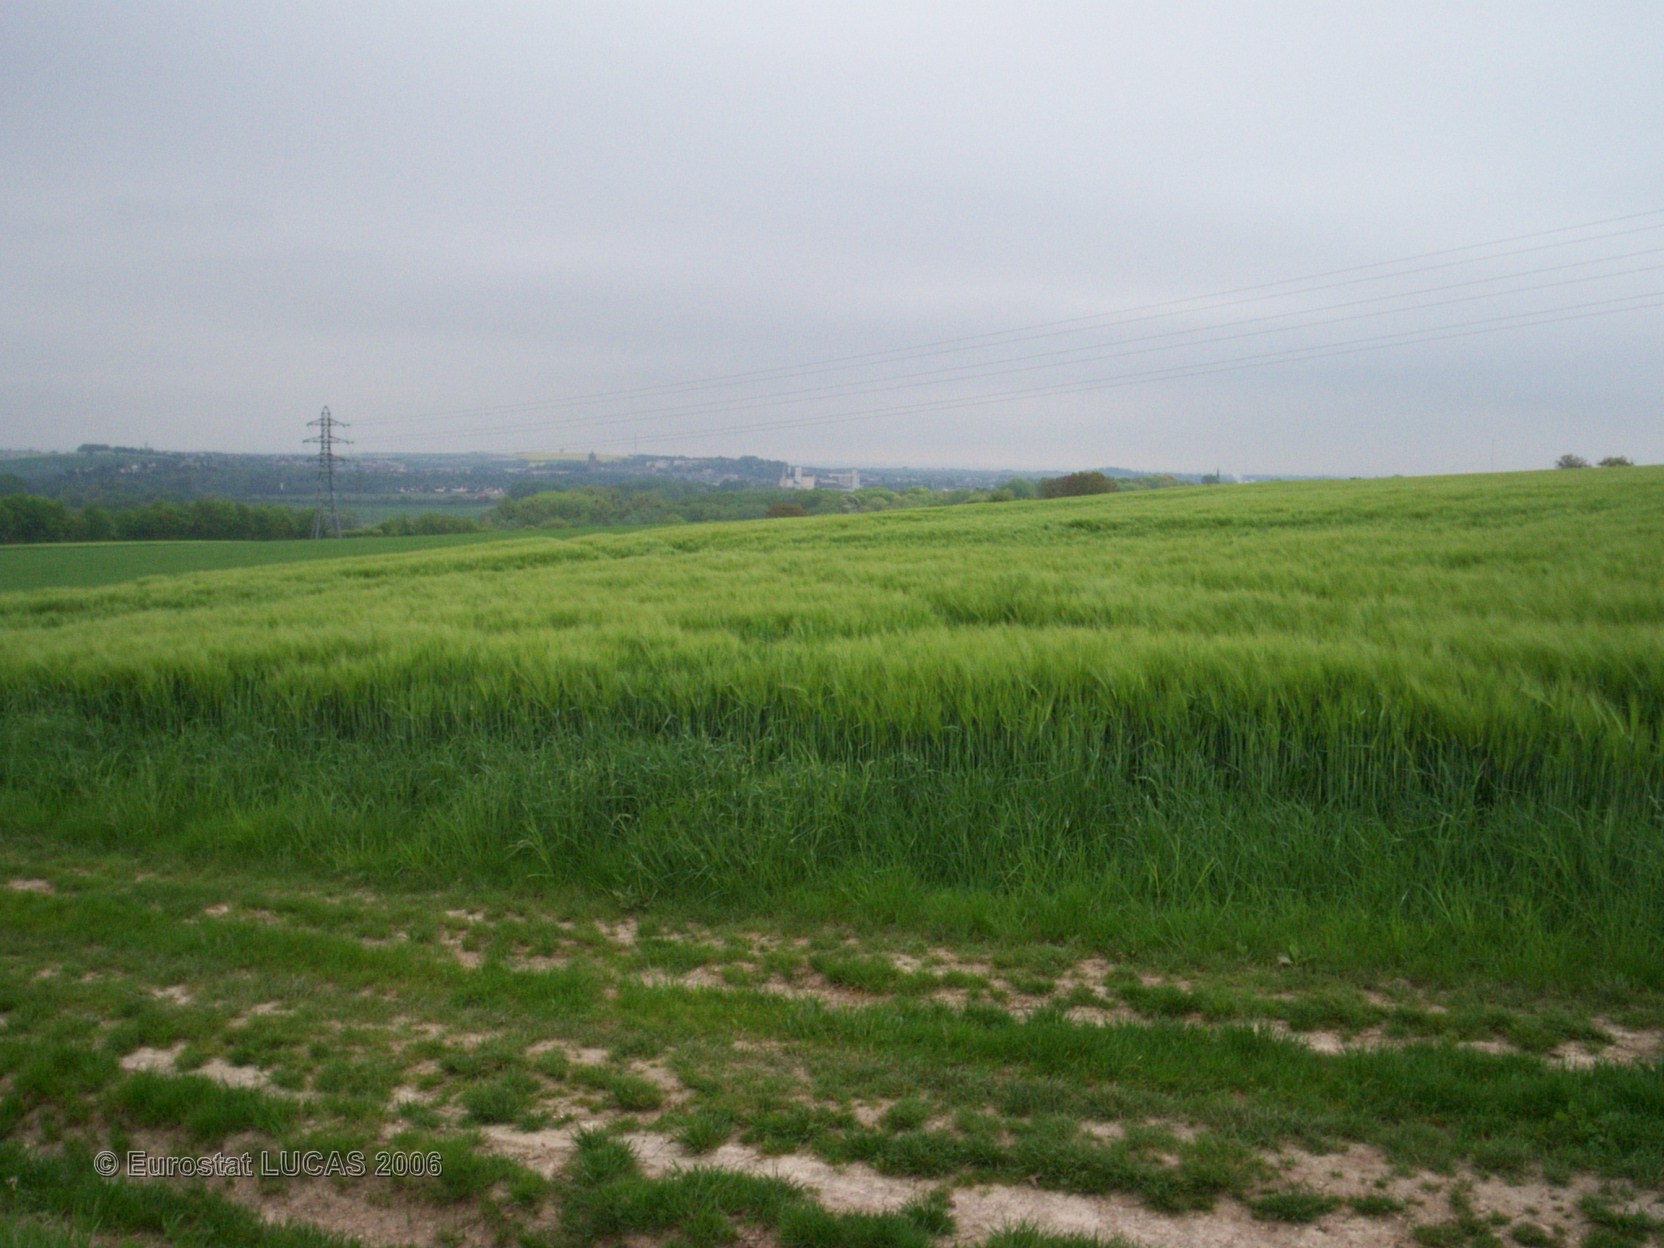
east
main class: Cropland
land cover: Common wheat
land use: Agriculture (excluding fallow land and kitchen gardens)
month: May
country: FR
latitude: 49.5018
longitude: 4.3204
